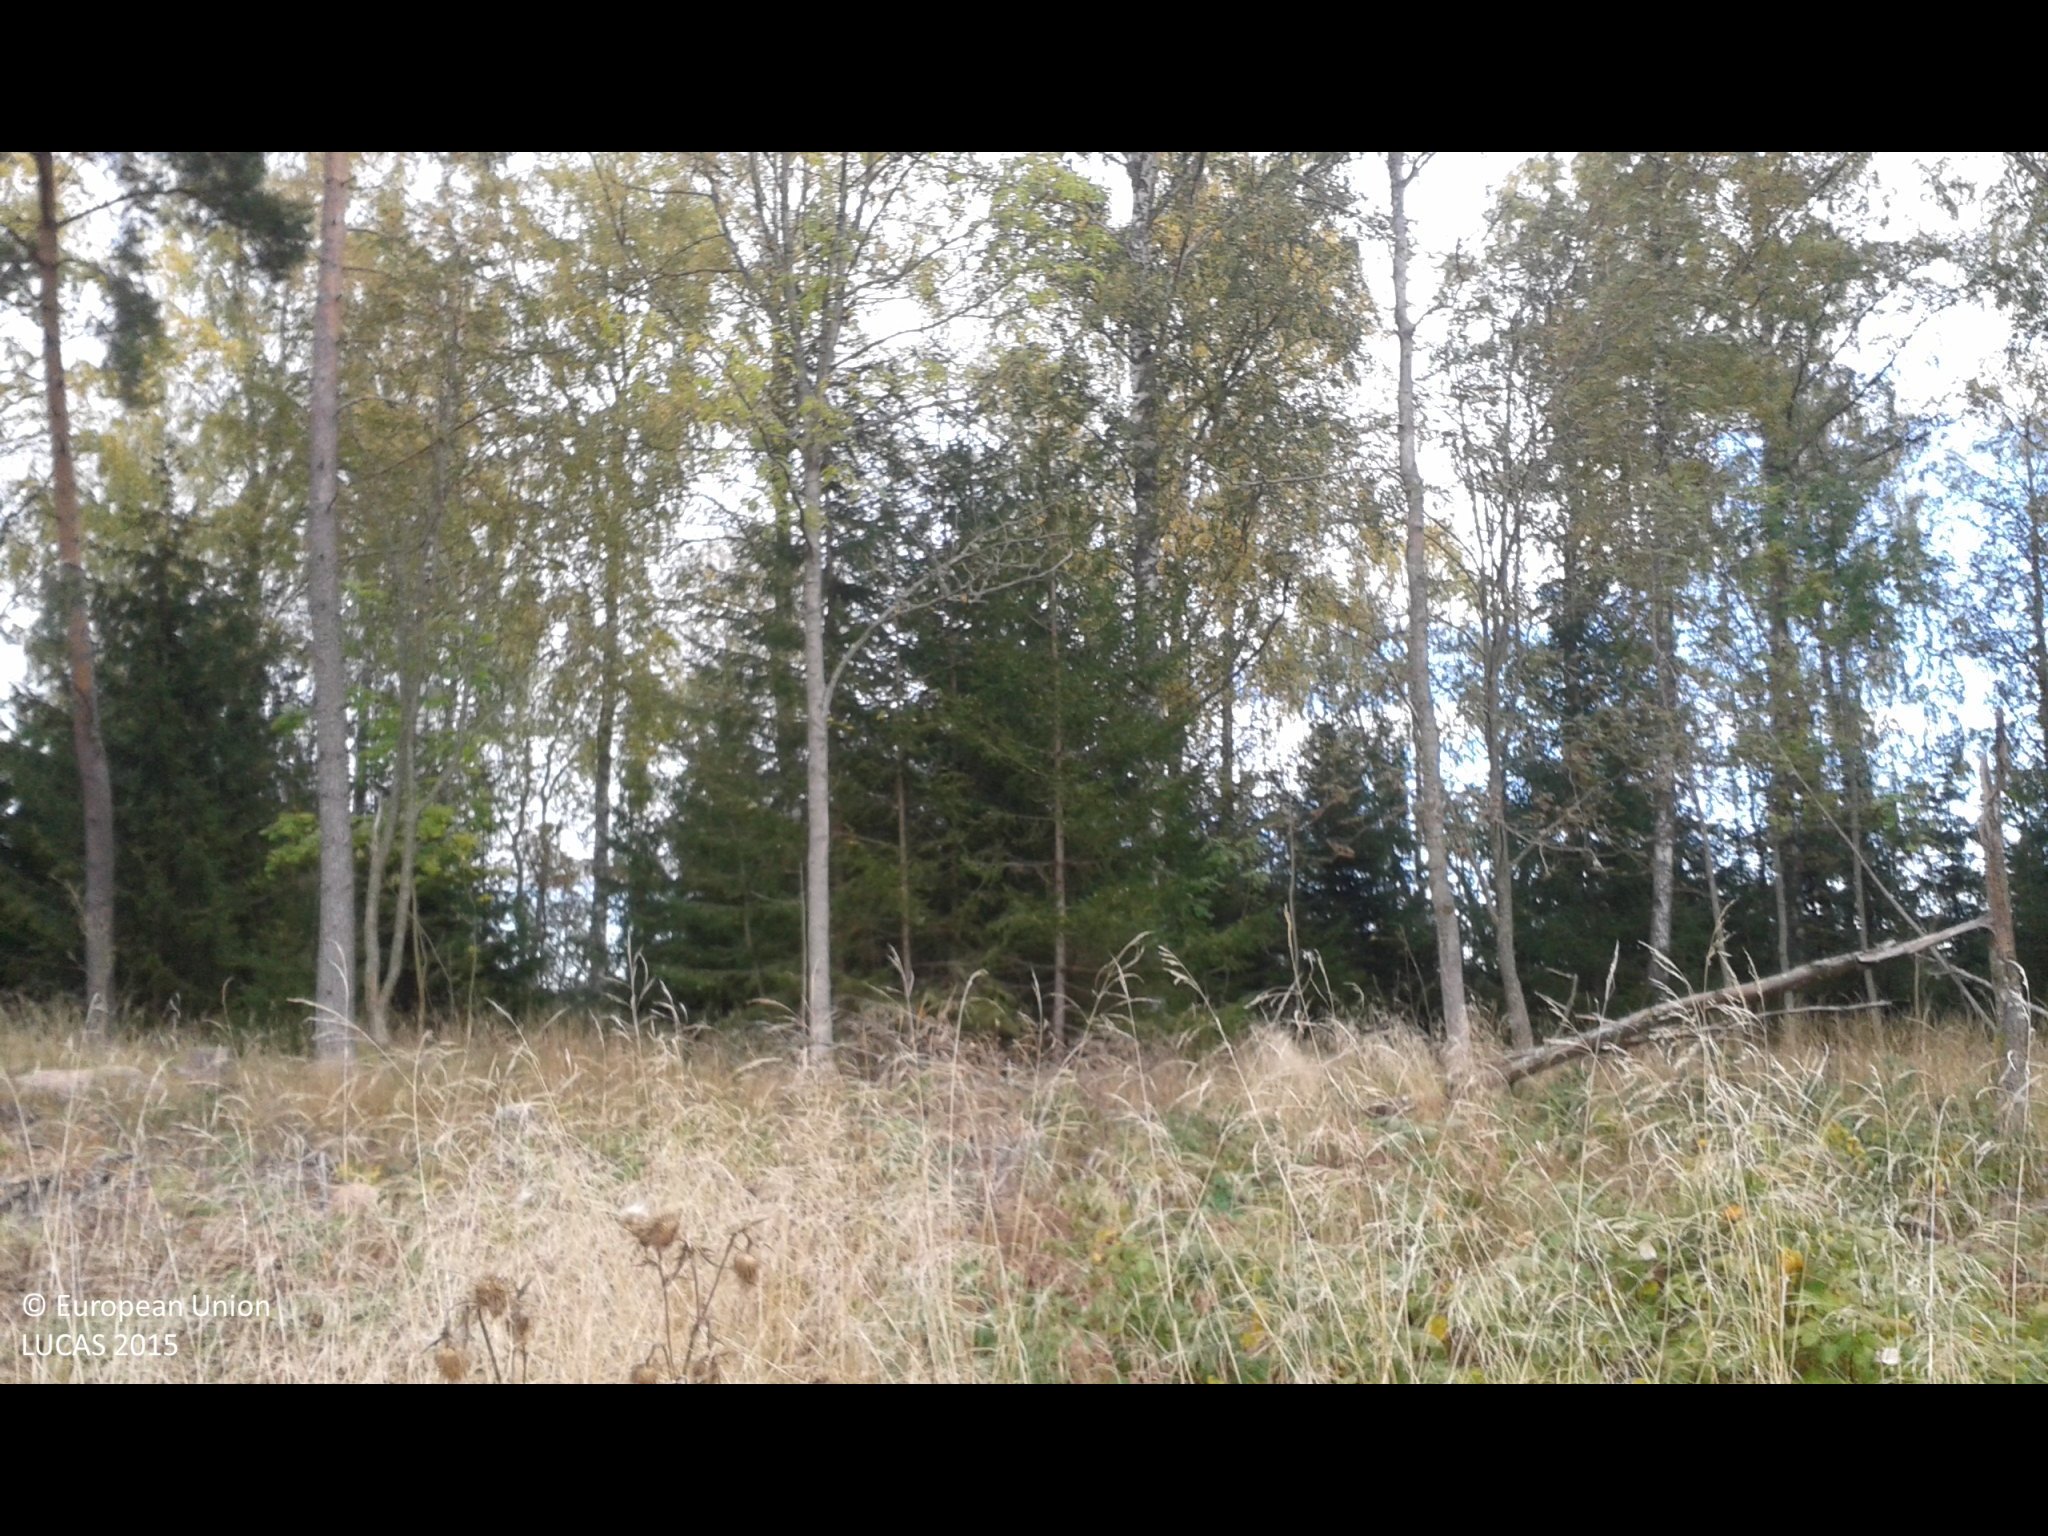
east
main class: Grassland
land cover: Spontaneously vegetated surfaces
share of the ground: > 75 %
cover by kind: herbaceous plants 100 %
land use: Forestry
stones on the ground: 10 - 25 %
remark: Clear cut
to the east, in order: Spontaneously vegetated surfaces; Spruce dominated mixed woodland; Groves; Inland fresh water bodies
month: October
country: SE
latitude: 58.7614
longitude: 17.3106
